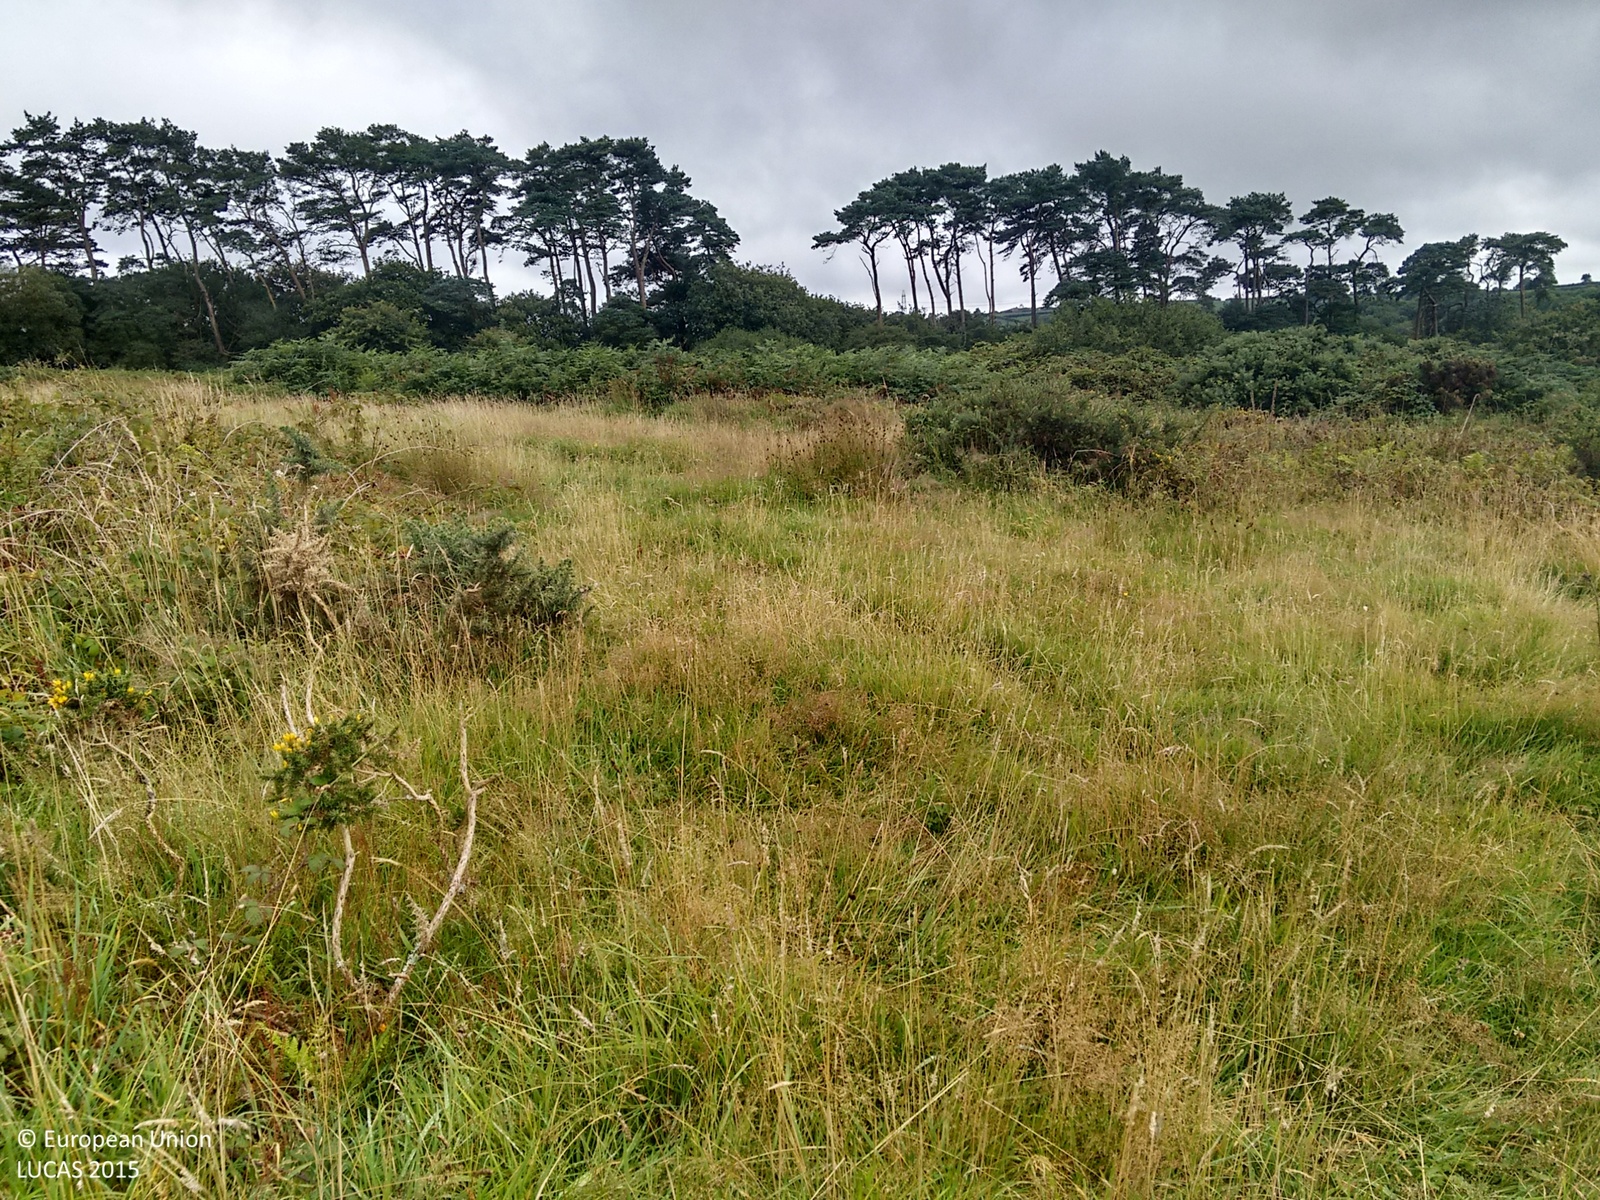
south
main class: Shrubland
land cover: Shrubland with sparse tree cover
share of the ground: > 75 %
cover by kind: herbaceous plants 65 %, shrubs 30 %, broadleaved forest trees 5 %
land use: Agriculture (excluding fallow land and kitchen gardens)
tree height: < 5 m
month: August
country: GB
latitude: 51.7625
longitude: -4.7302
